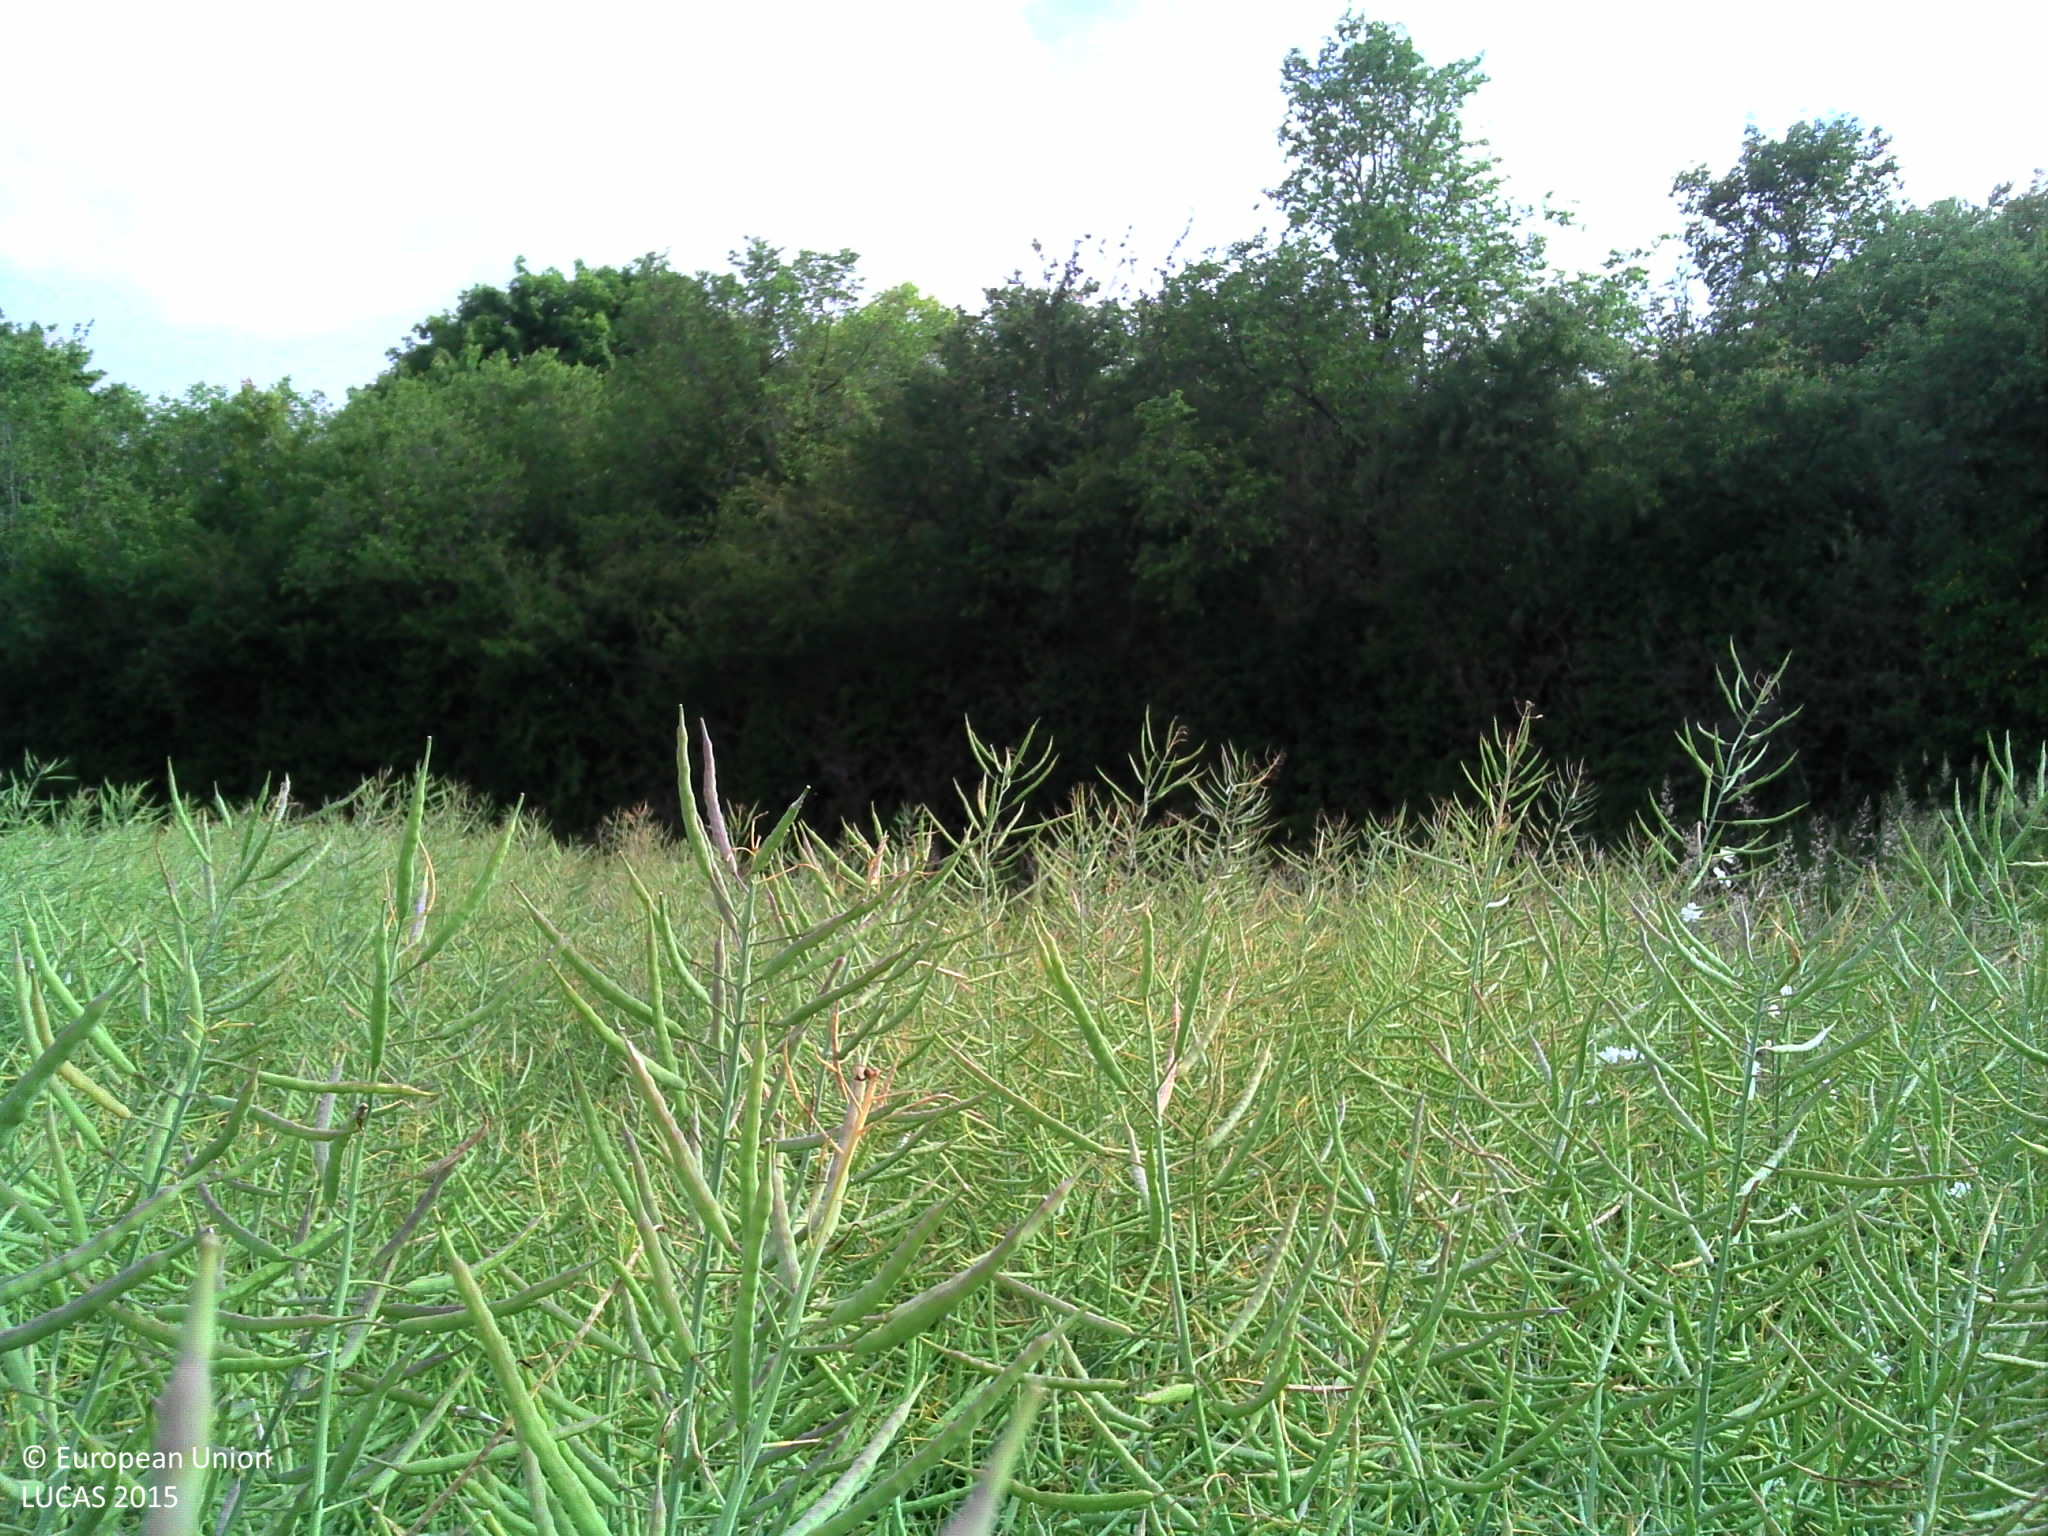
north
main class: Cropland
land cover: Rape and turnip rape
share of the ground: > 75 %
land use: Agriculture (excluding fallow land and kitchen gardens)
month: June
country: FR
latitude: 46.9336
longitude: 2.7047
